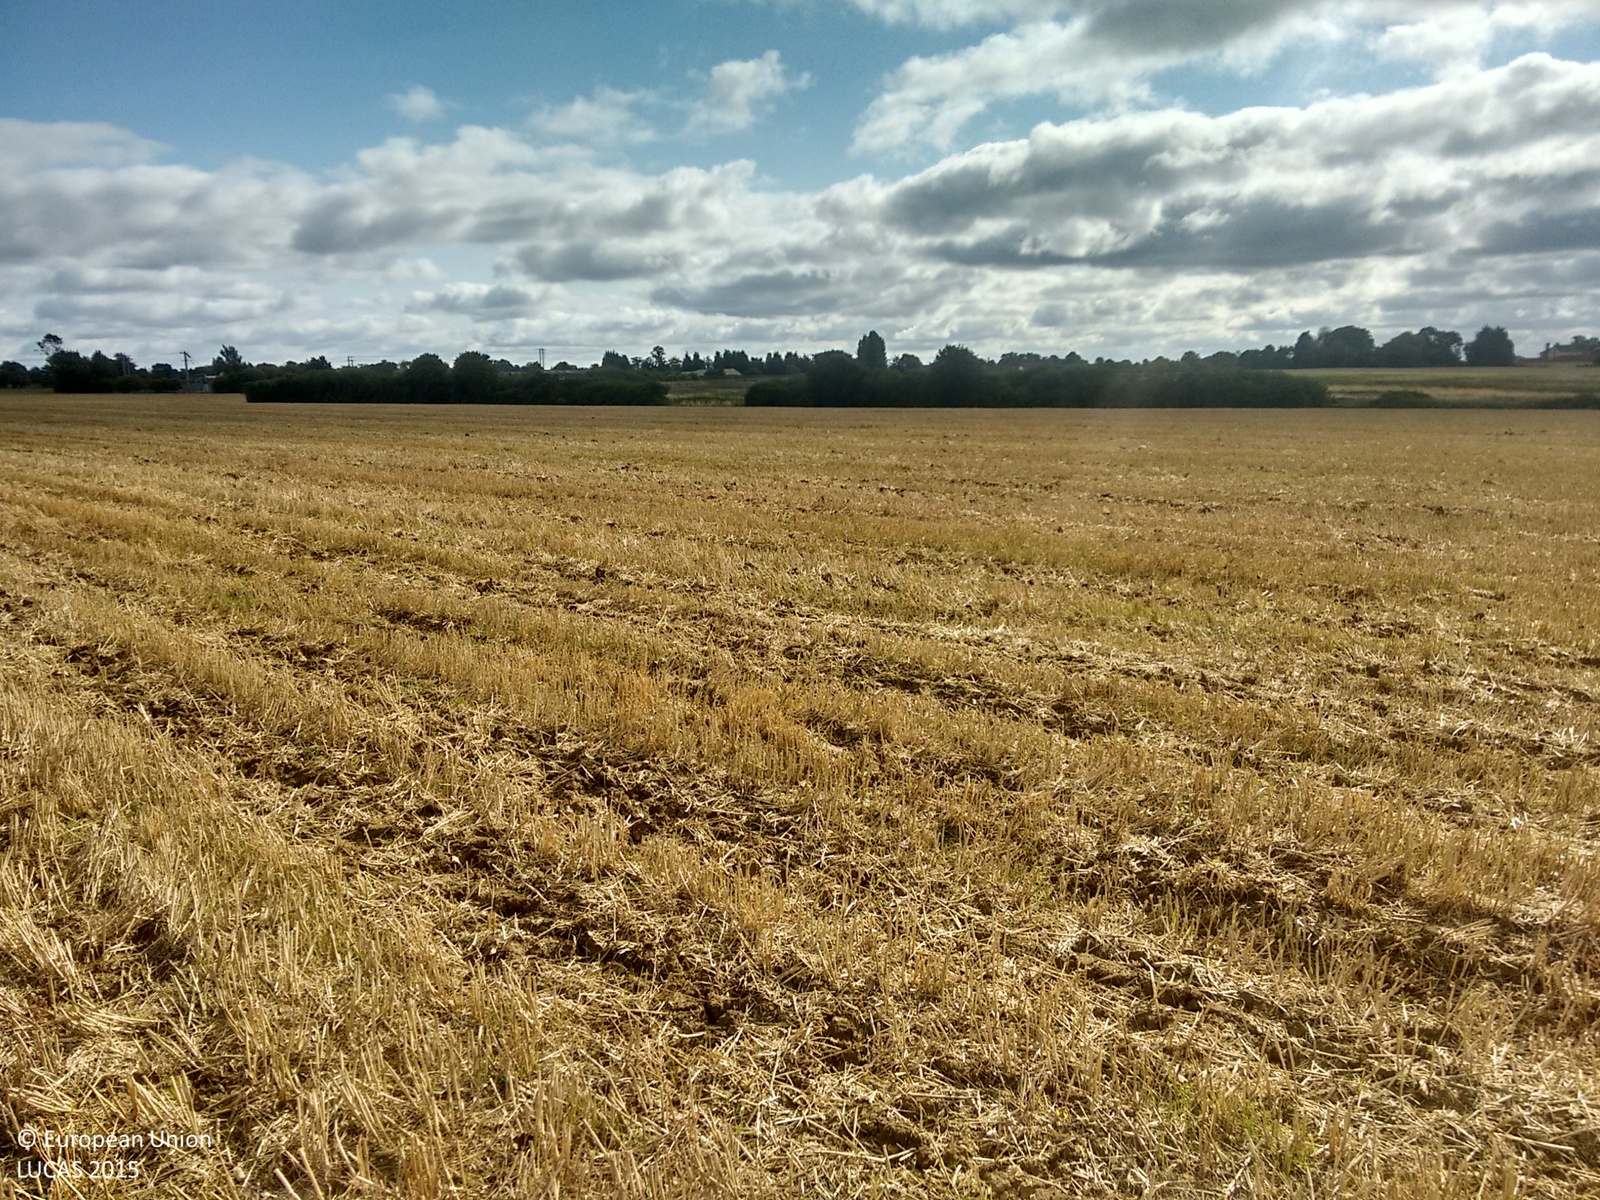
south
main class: Cropland
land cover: Common wheat
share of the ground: 25 - 50 %
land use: Agriculture (excluding fallow land and kitchen gardens)
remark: Harvested field
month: September
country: GB
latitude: 52.2453
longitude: 0.9101
